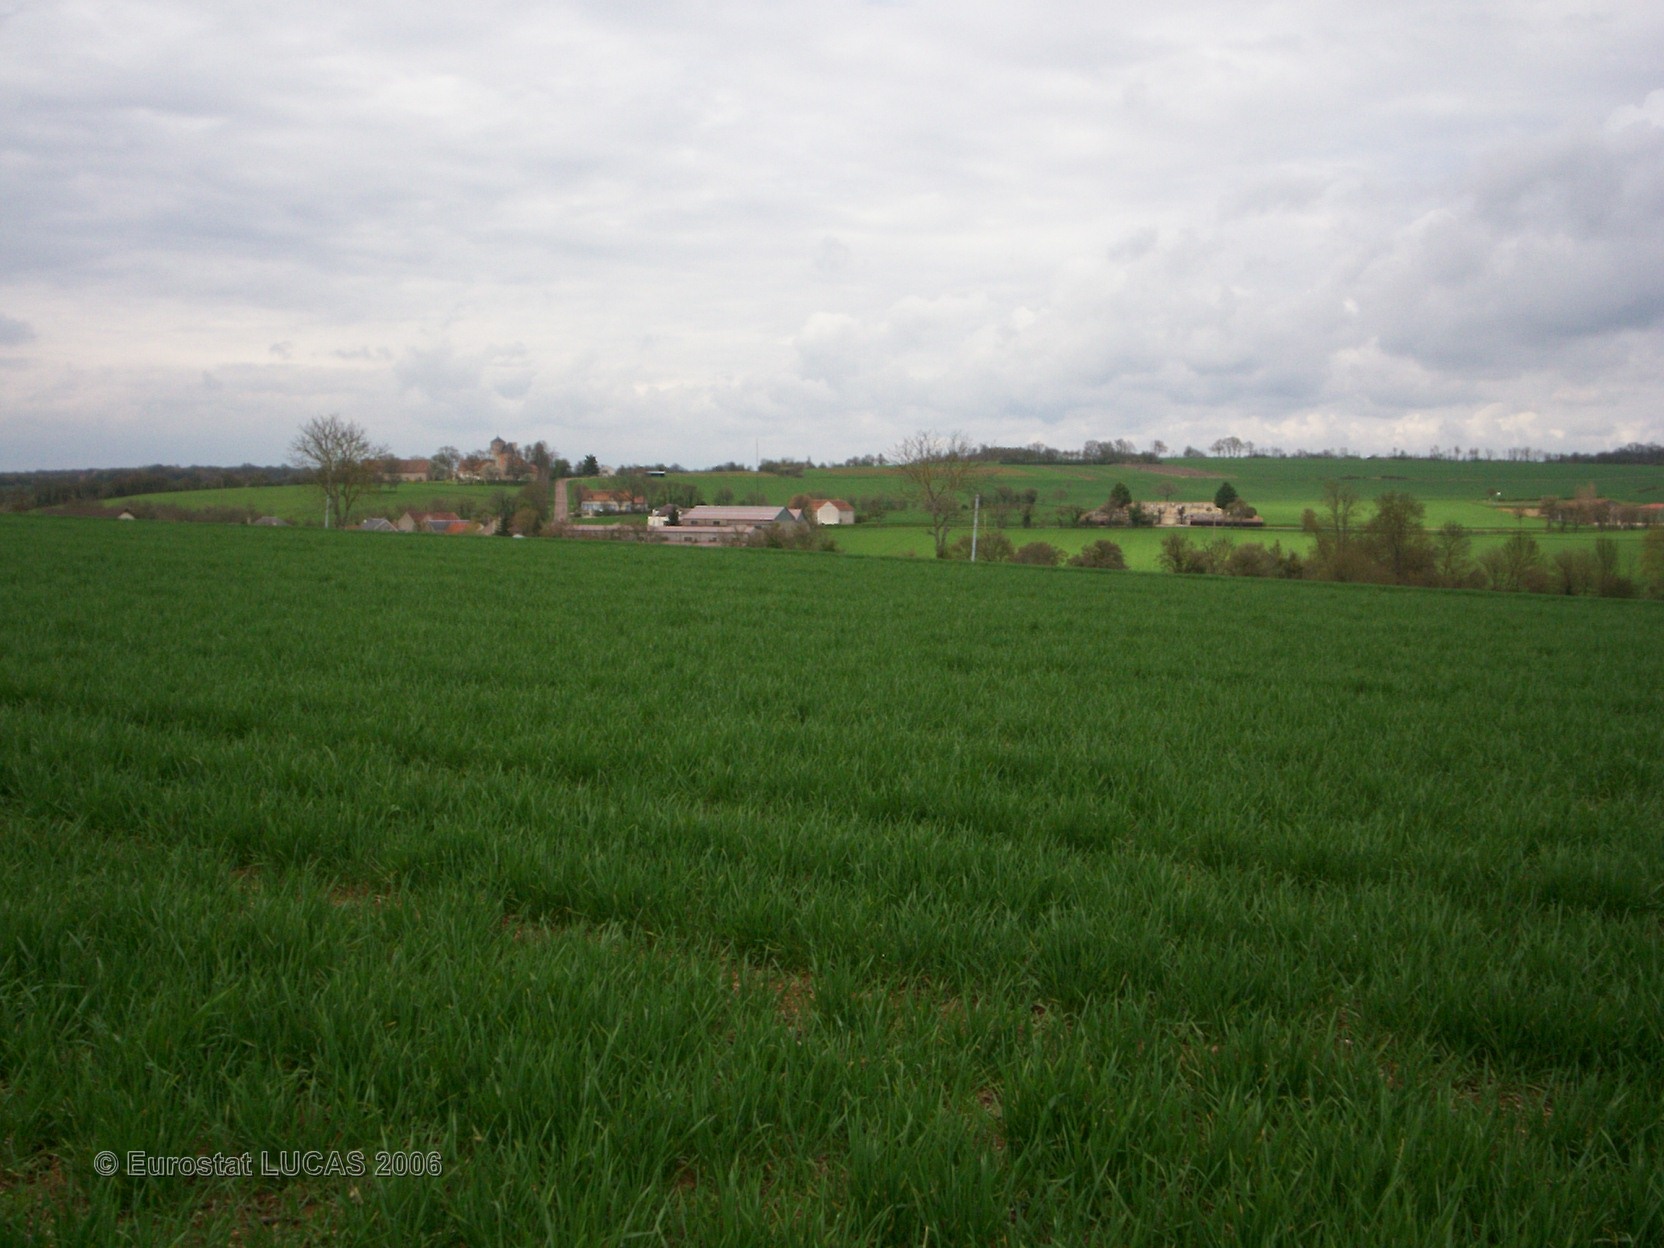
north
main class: Cropland
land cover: Common wheat
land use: Agriculture (excluding fallow land and kitchen gardens)
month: April
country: FR
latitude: 47.4414
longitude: 3.0062
